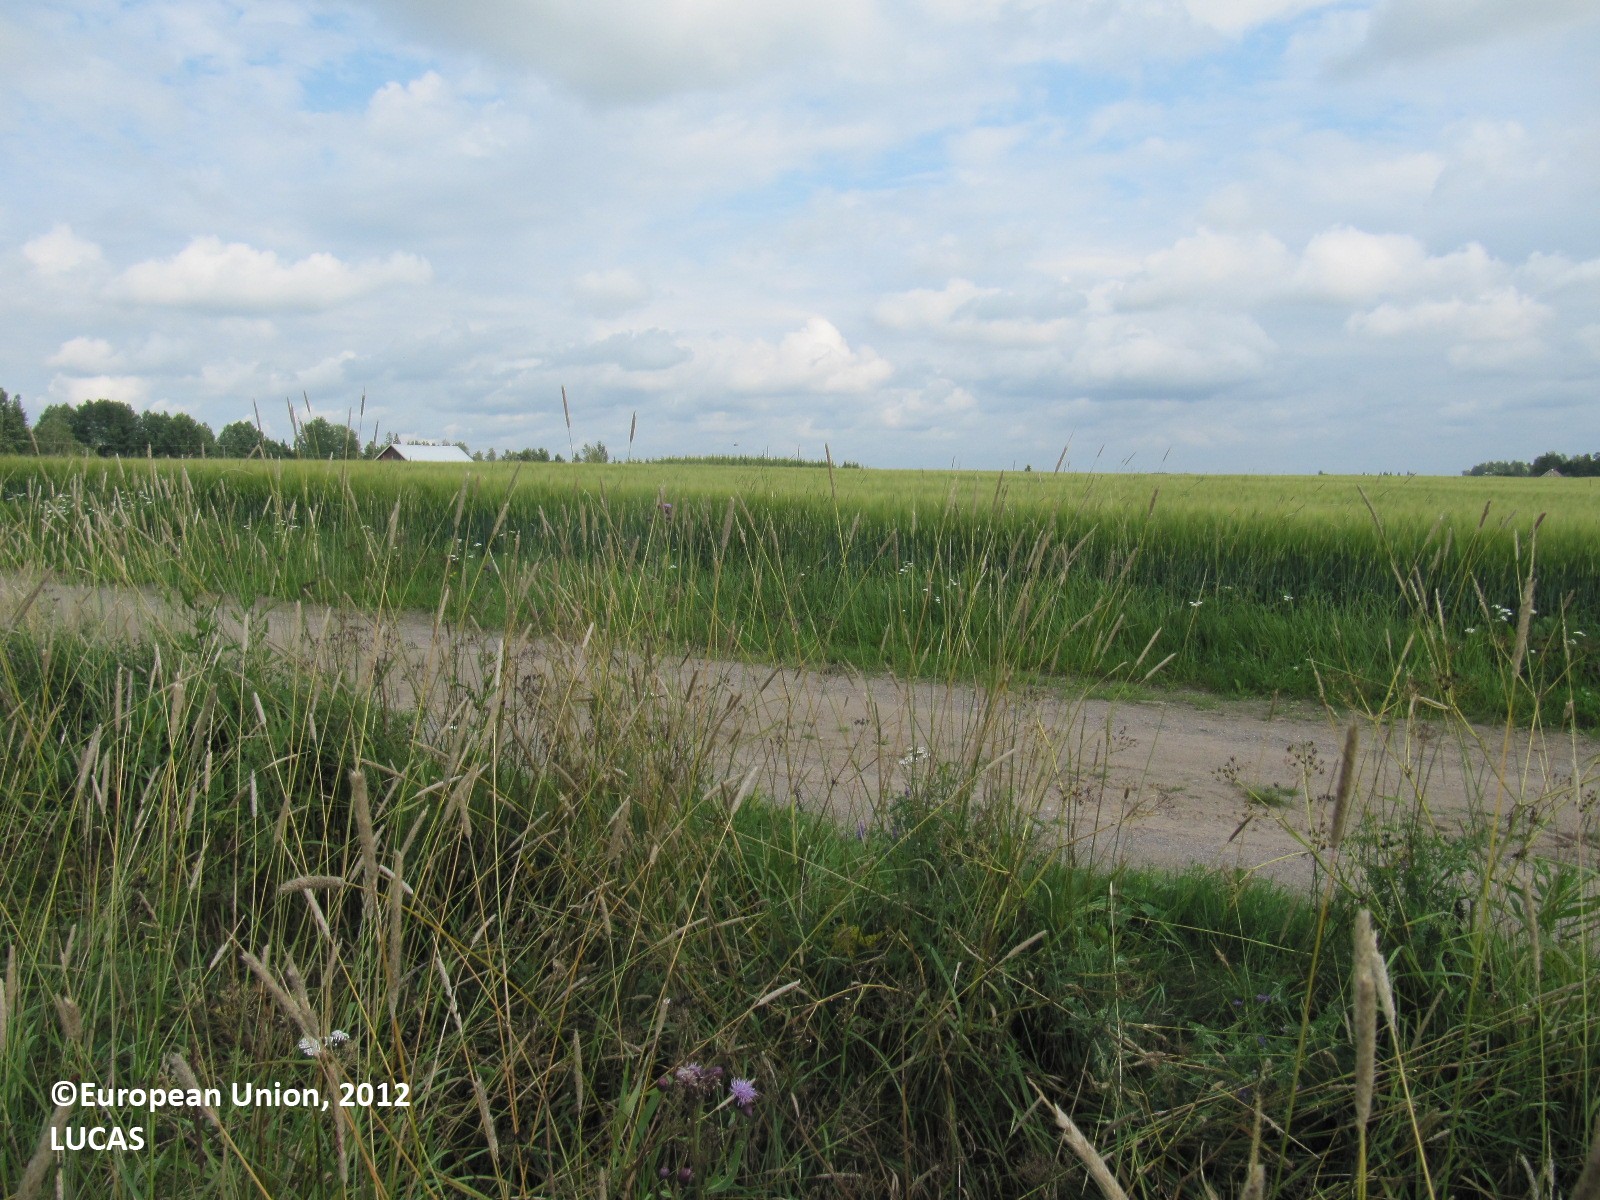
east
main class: Cropland
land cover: Barley
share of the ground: > 75 %
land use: Agriculture (excluding fallow land and kitchen gardens)
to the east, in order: Barley; Grass margins; Ditches and canals; Grass margins; Paved roads, cycling and walking lanes; Grass margins; Barley
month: July
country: FI
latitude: 60.6623
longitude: 23.3110
